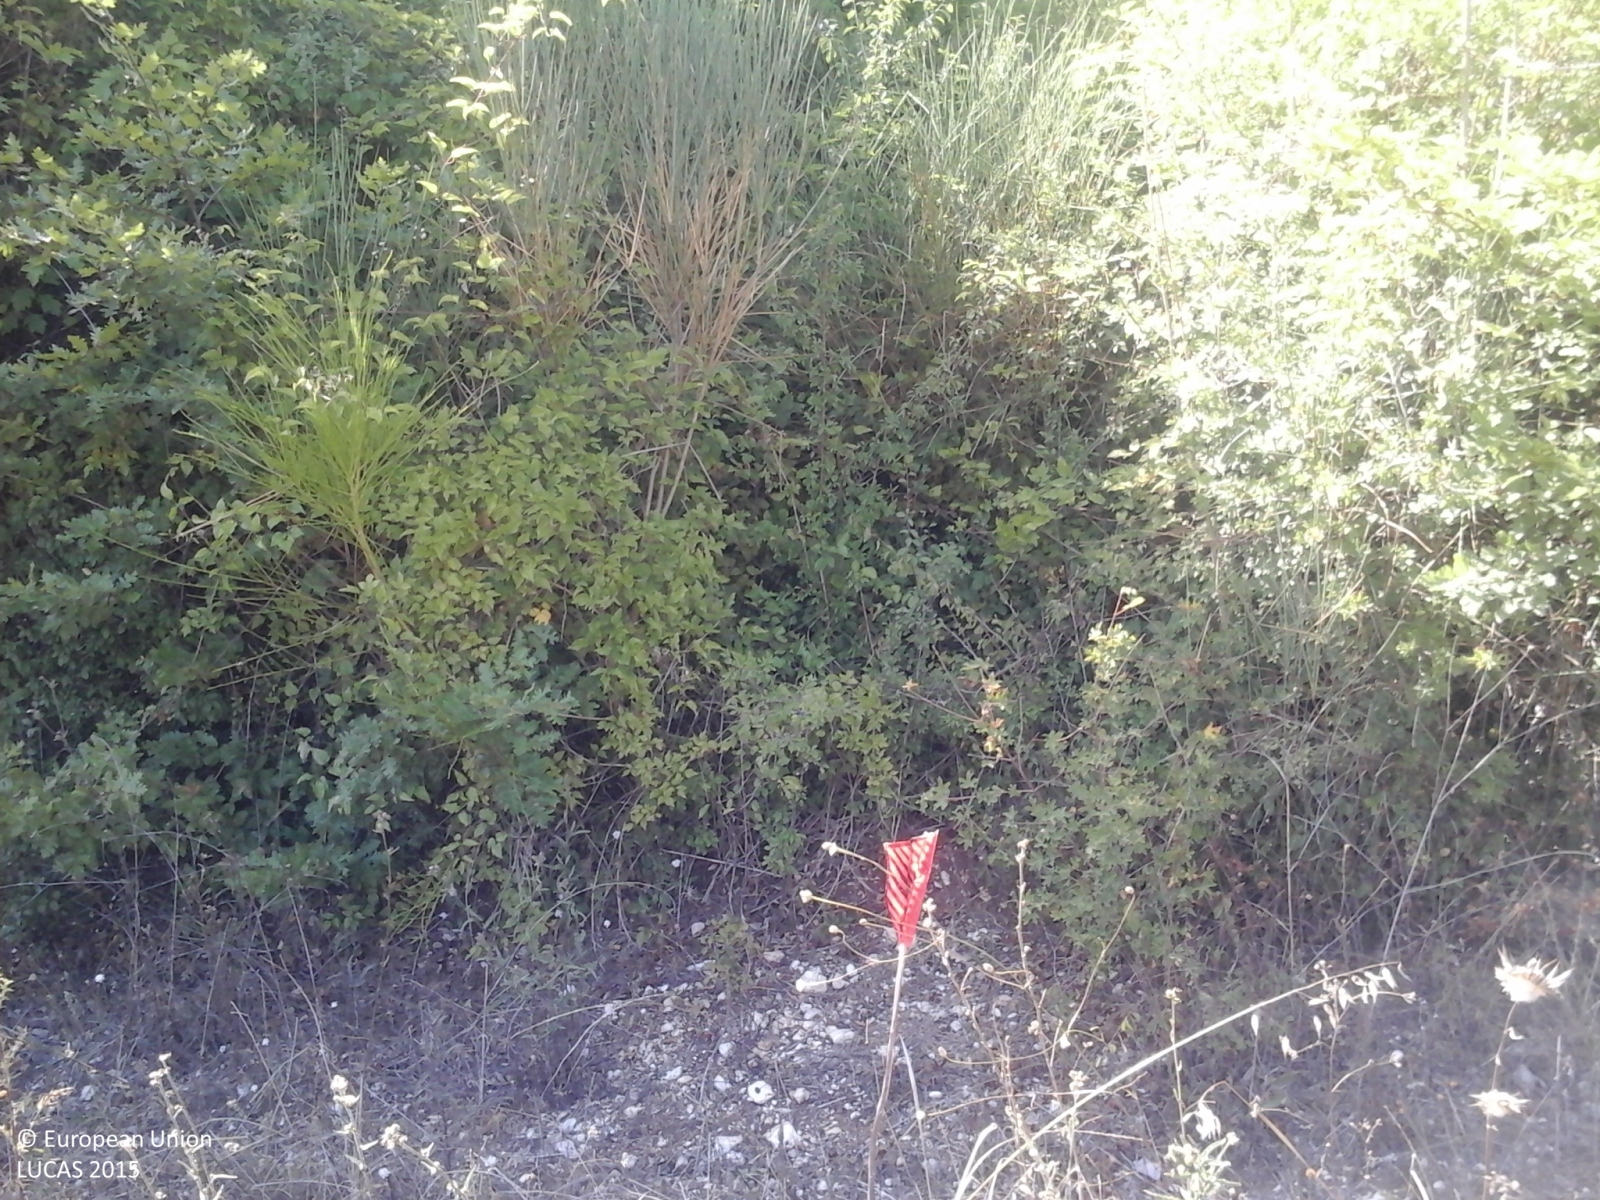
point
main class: Woodland
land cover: Broadleaved woodland
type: thermophilous deciduous forest
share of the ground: > 75 %
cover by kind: broadleaved forest trees 80 %, shrubs 20 %
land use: Forestry
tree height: < 5 m
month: August
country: IT
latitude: 42.6438
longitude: 12.3950
